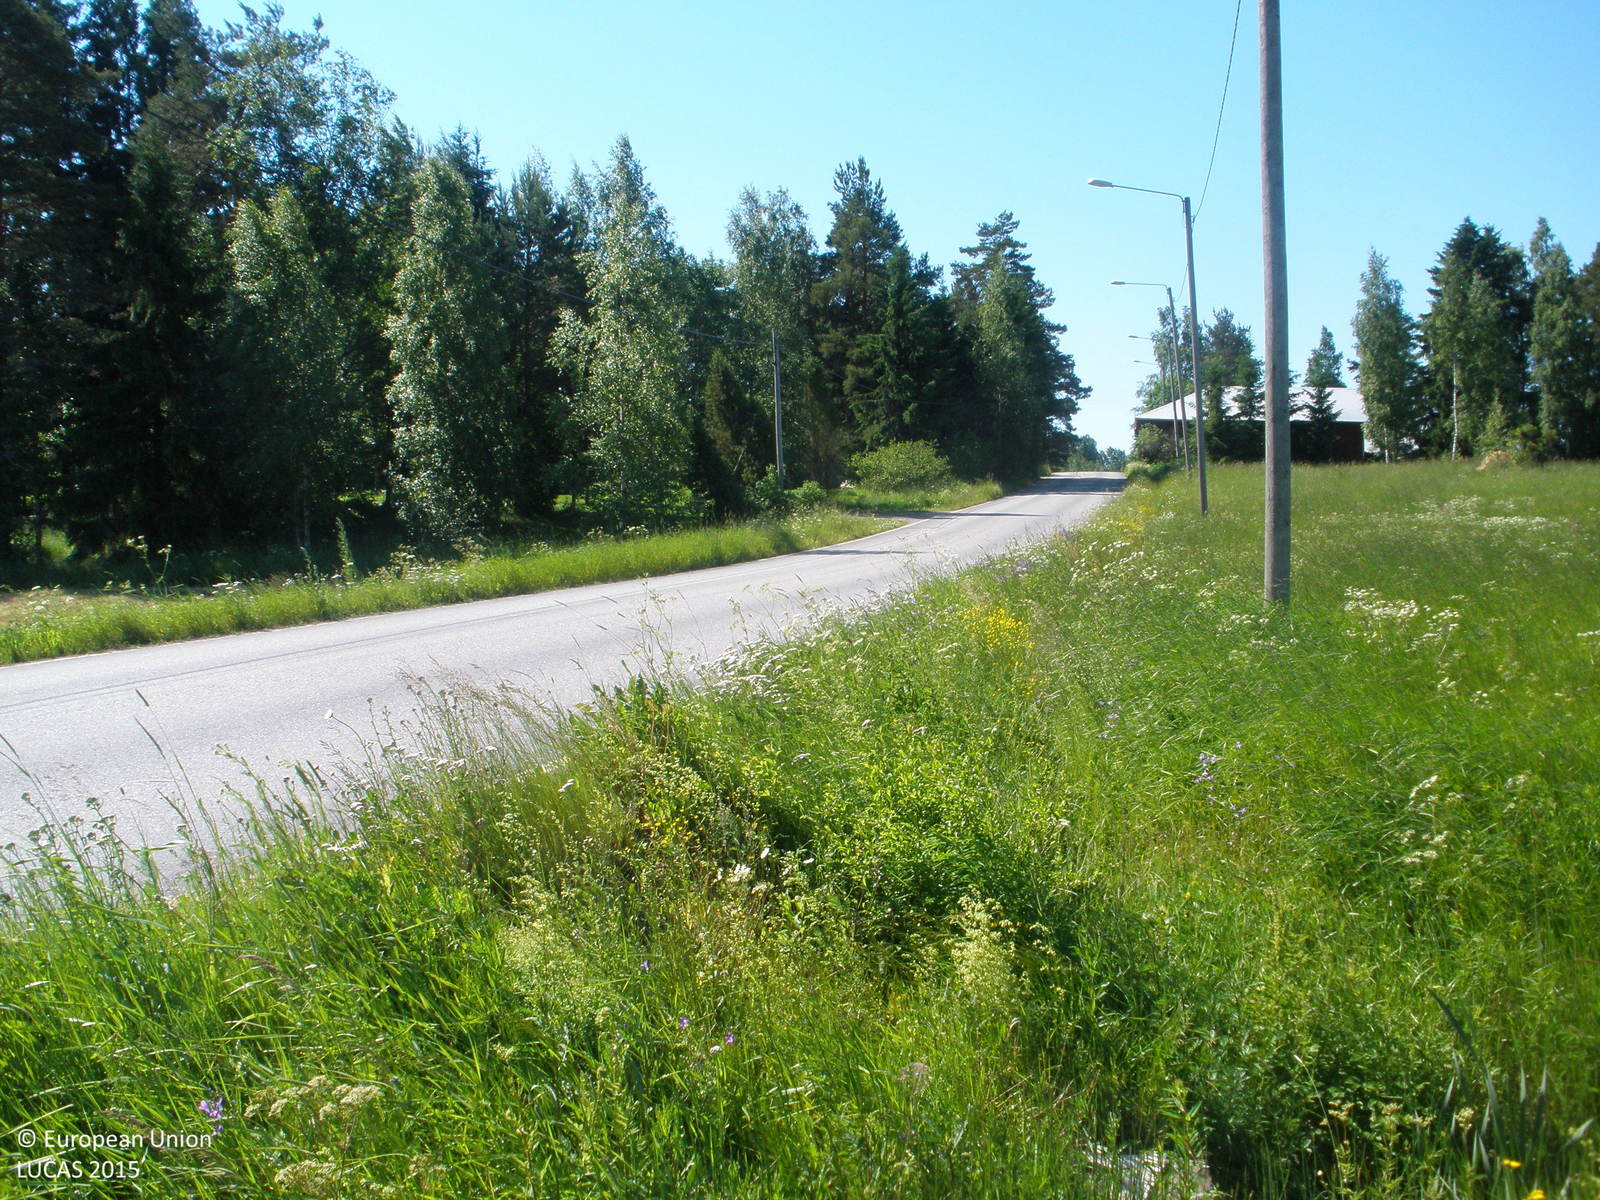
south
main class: Cropland
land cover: Floriculture and ornamental plants
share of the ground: > 75 %
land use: Agriculture (excluding fallow land and kitchen gardens)
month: July
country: FI
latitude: 61.1489
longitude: 23.5898
